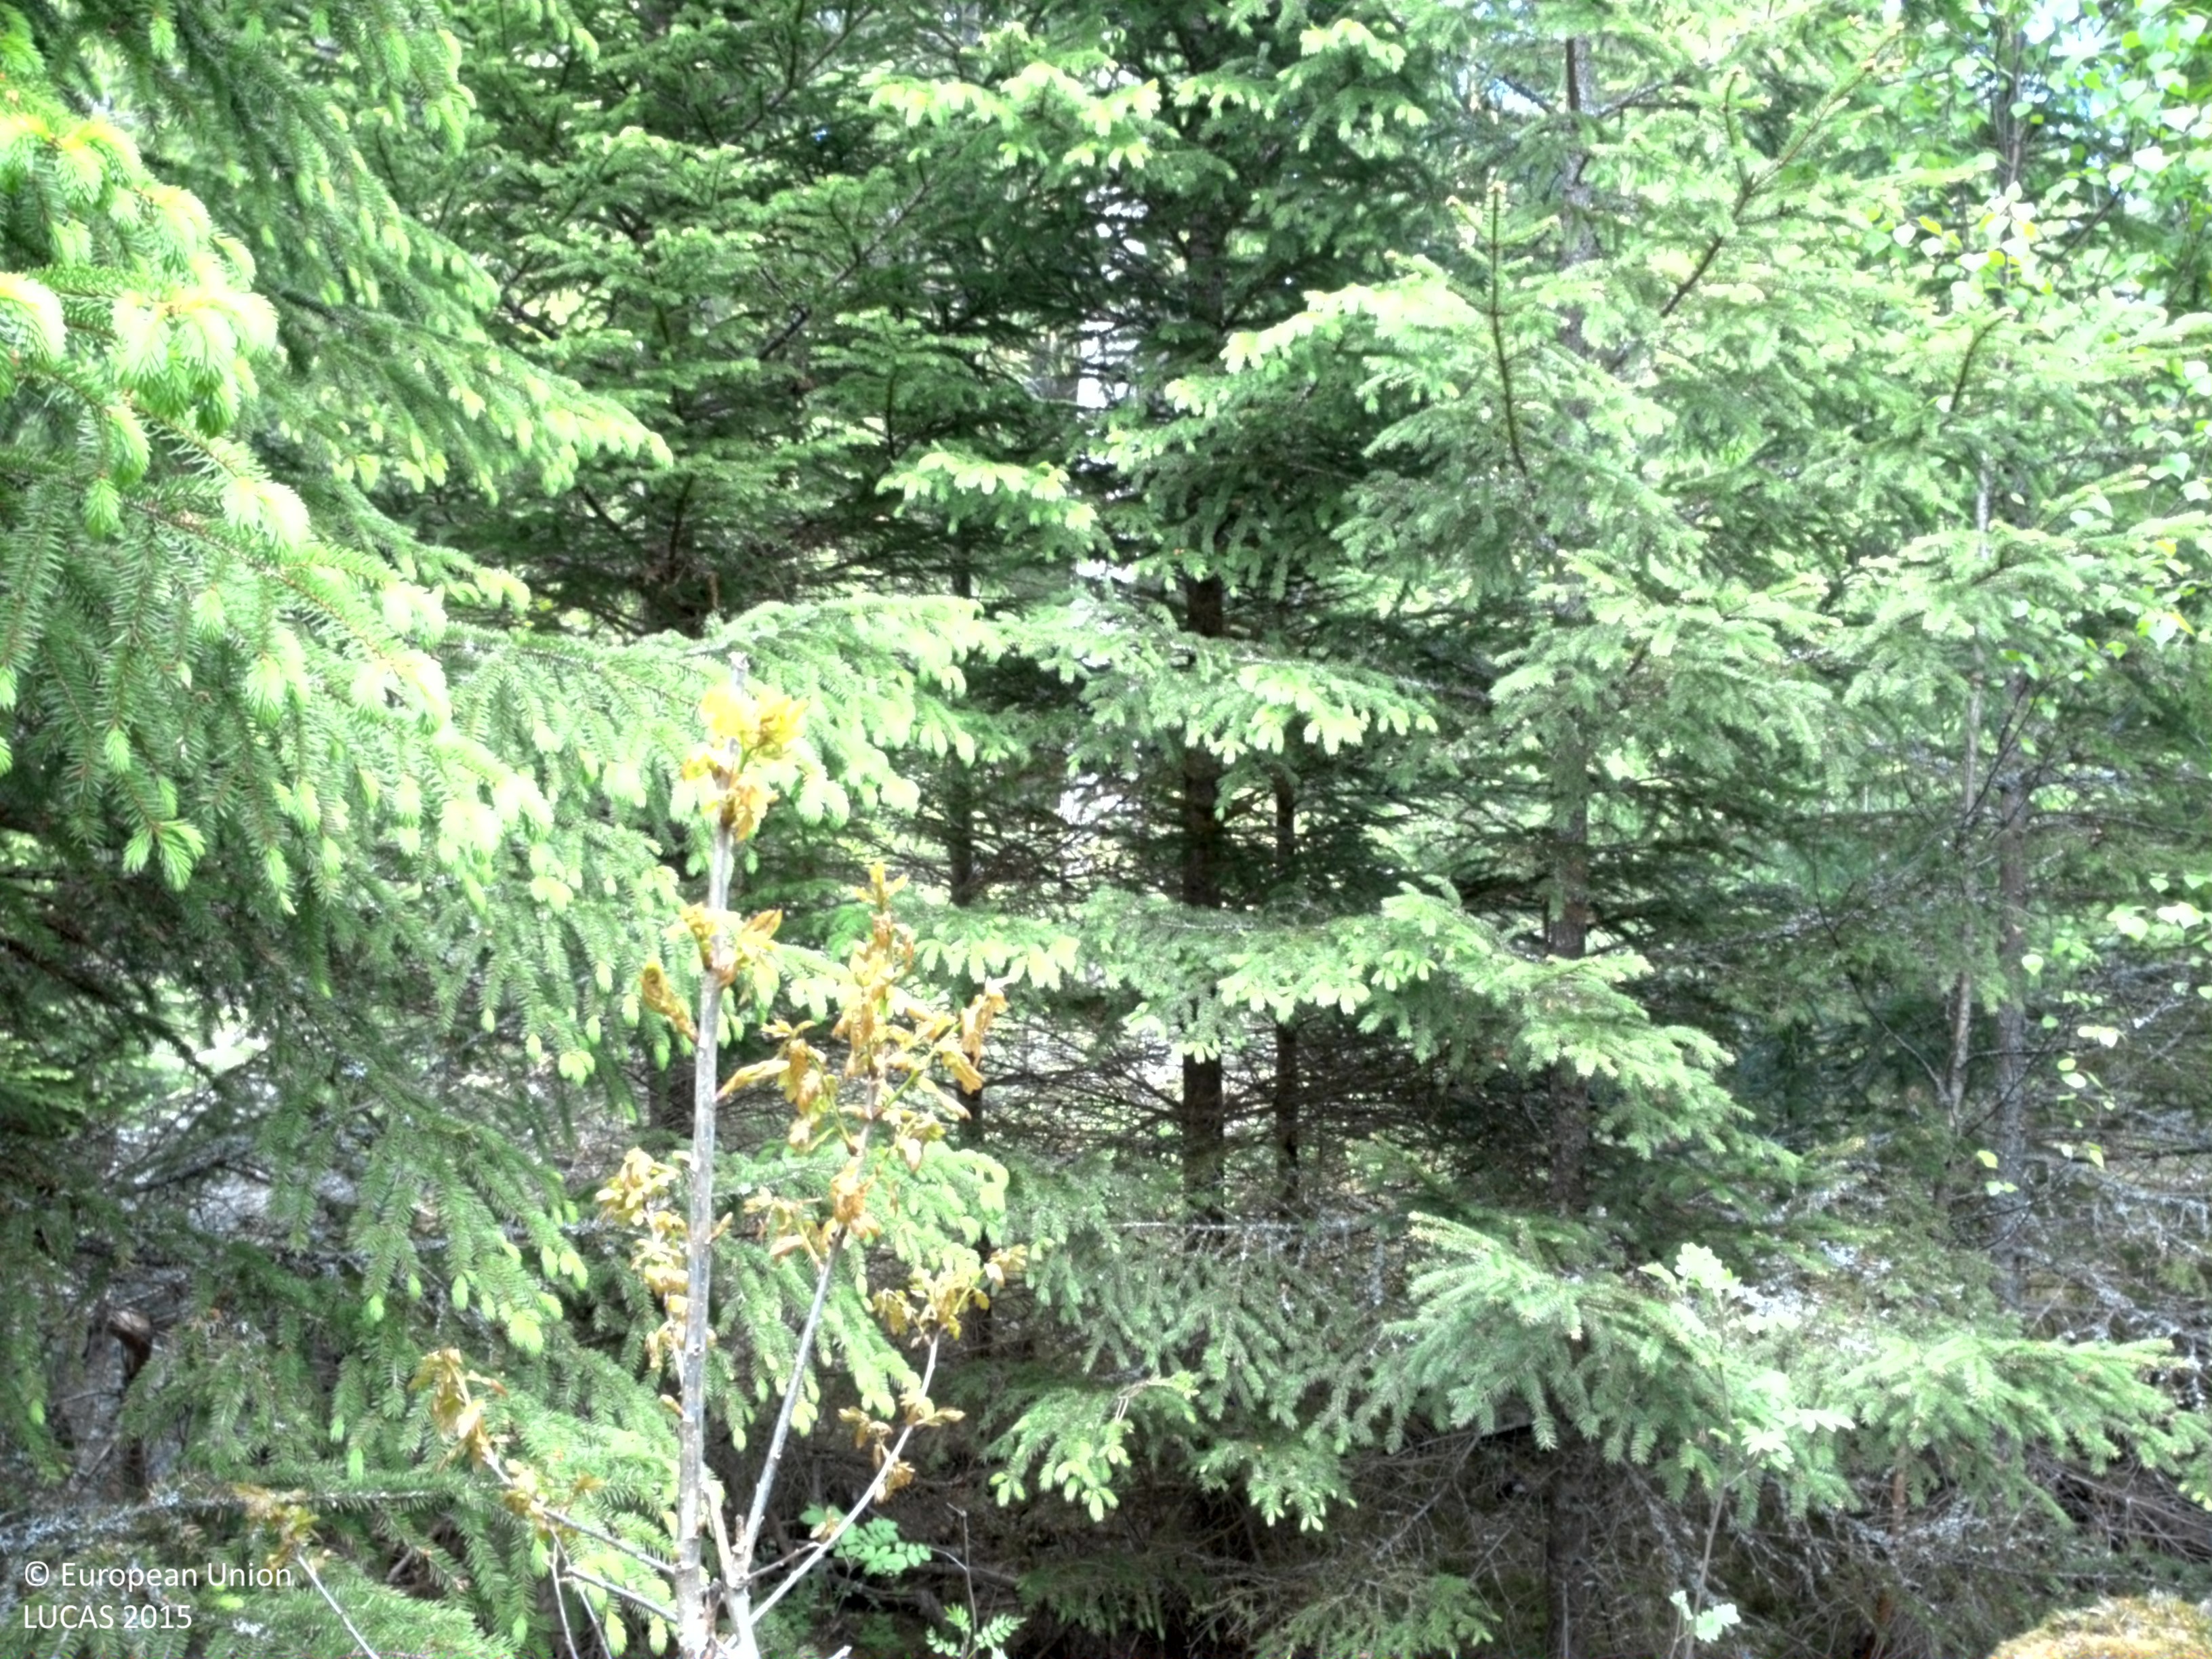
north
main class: Woodland
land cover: Spruce dominated coniferous woodland
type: boreal forest
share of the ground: 50 - 75 %
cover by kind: coniferous forest trees 60 %, broadleaved forest trees 10 %, shrubs 10 %, herbaceous plants 10 %, lichens and mosses 10 %
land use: Forestry
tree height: > 5 m
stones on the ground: > 50 %
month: May
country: SE
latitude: 57.2565
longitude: 15.9827
